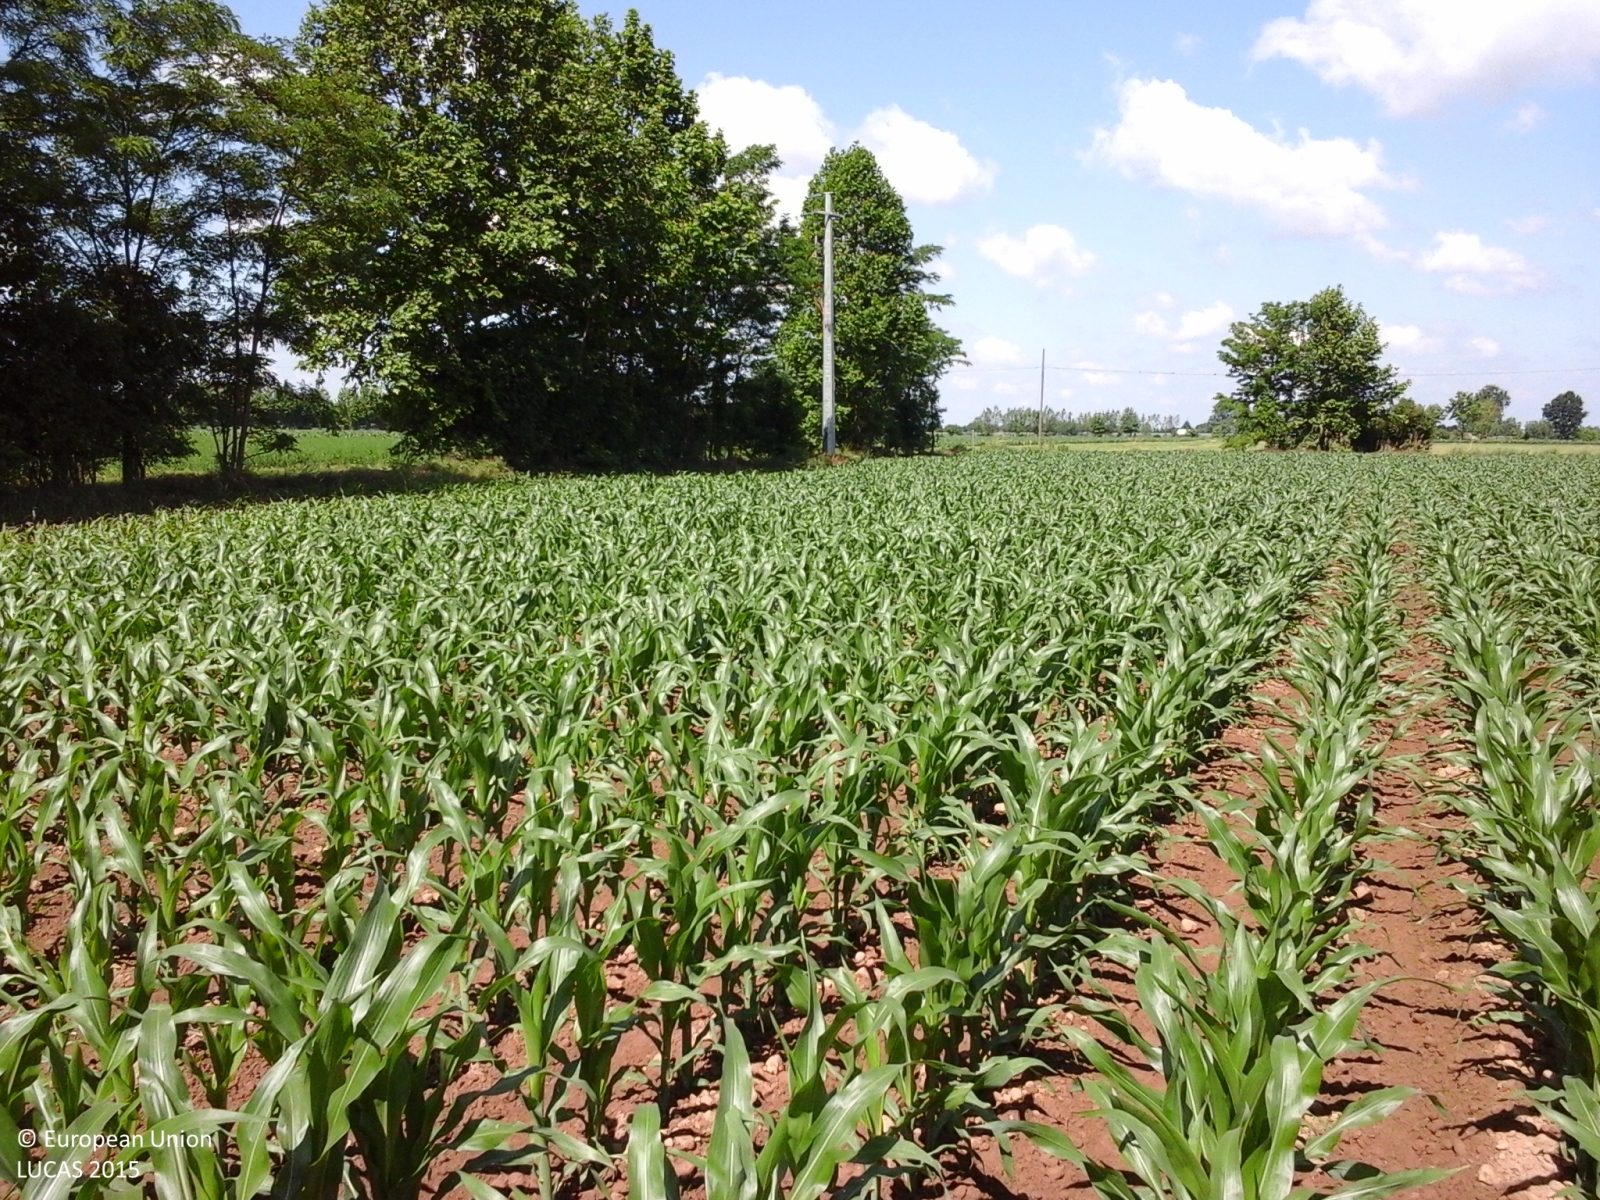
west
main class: Cropland
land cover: Maize
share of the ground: > 75 %
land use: Agriculture (excluding fallow land and kitchen gardens)
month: May
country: IT
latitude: 45.3240
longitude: 10.1655
